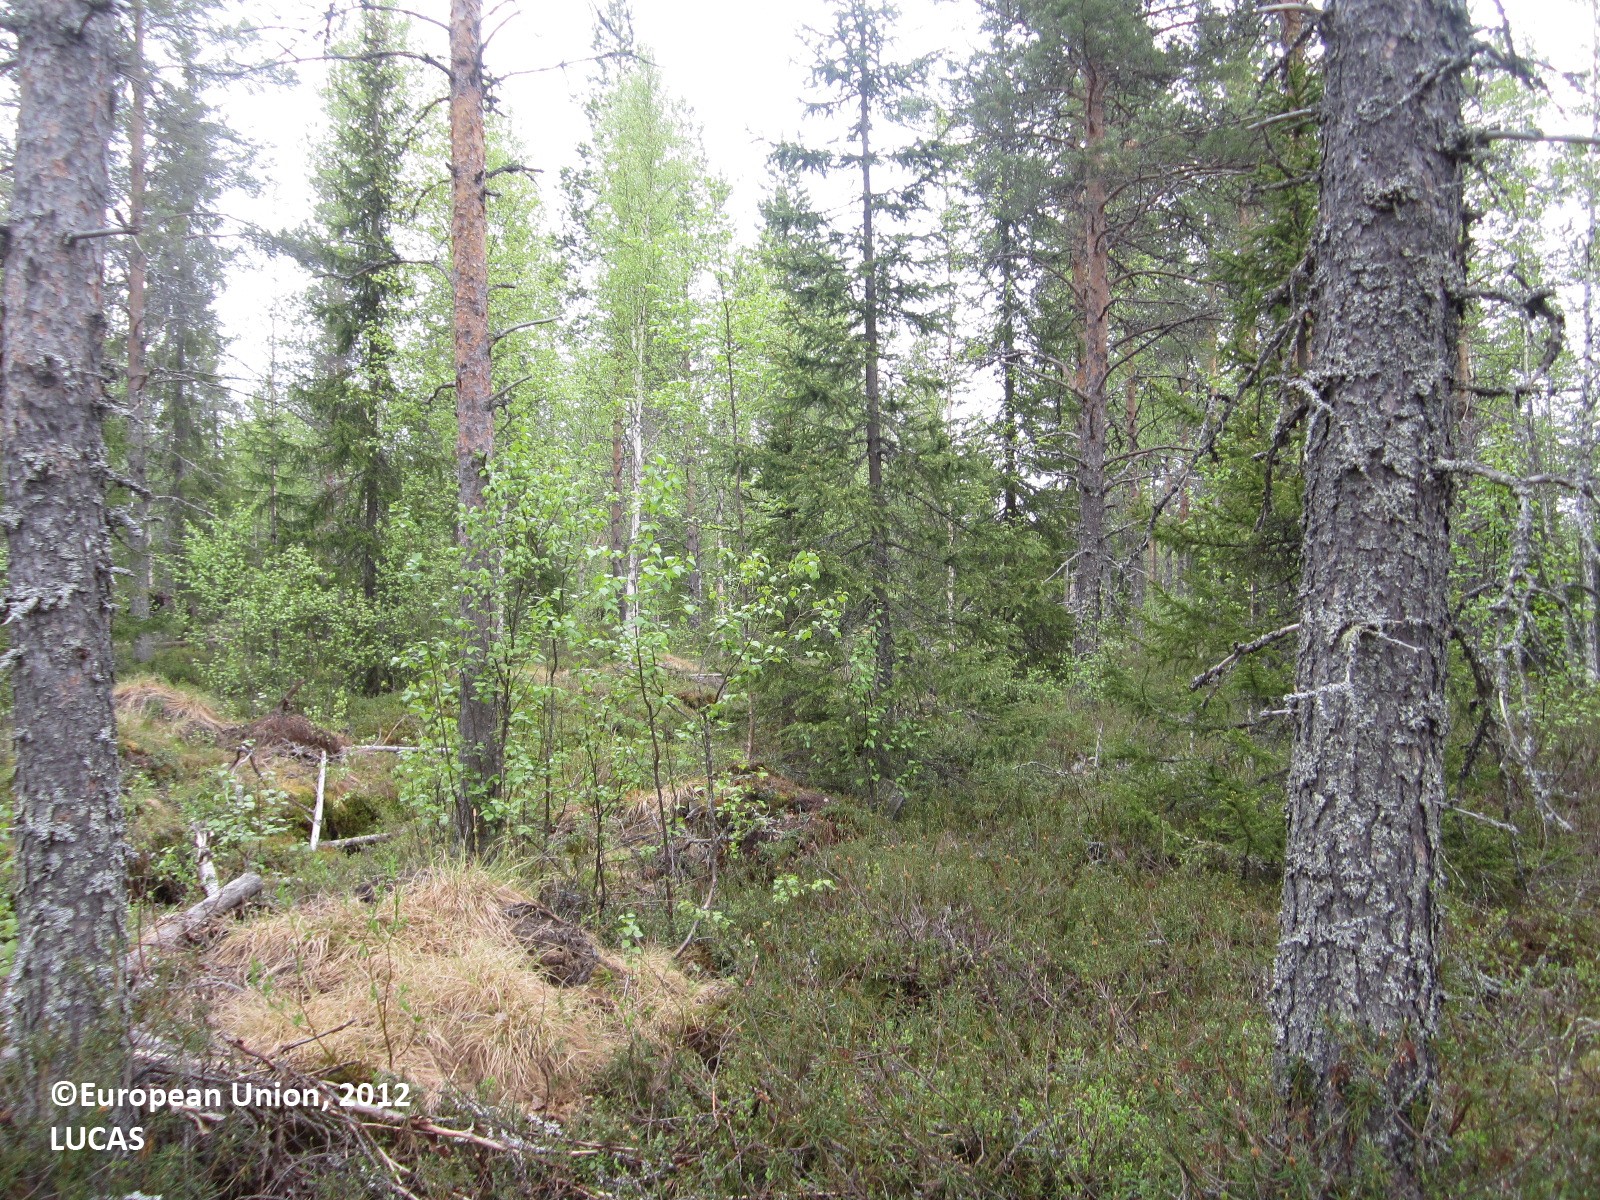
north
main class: Woodland
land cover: Pine dominated mixed woodland
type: boreal forest
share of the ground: > 75 %
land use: Forestry
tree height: > 5 m
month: June
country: FI
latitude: 64.7996
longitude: 28.7241
